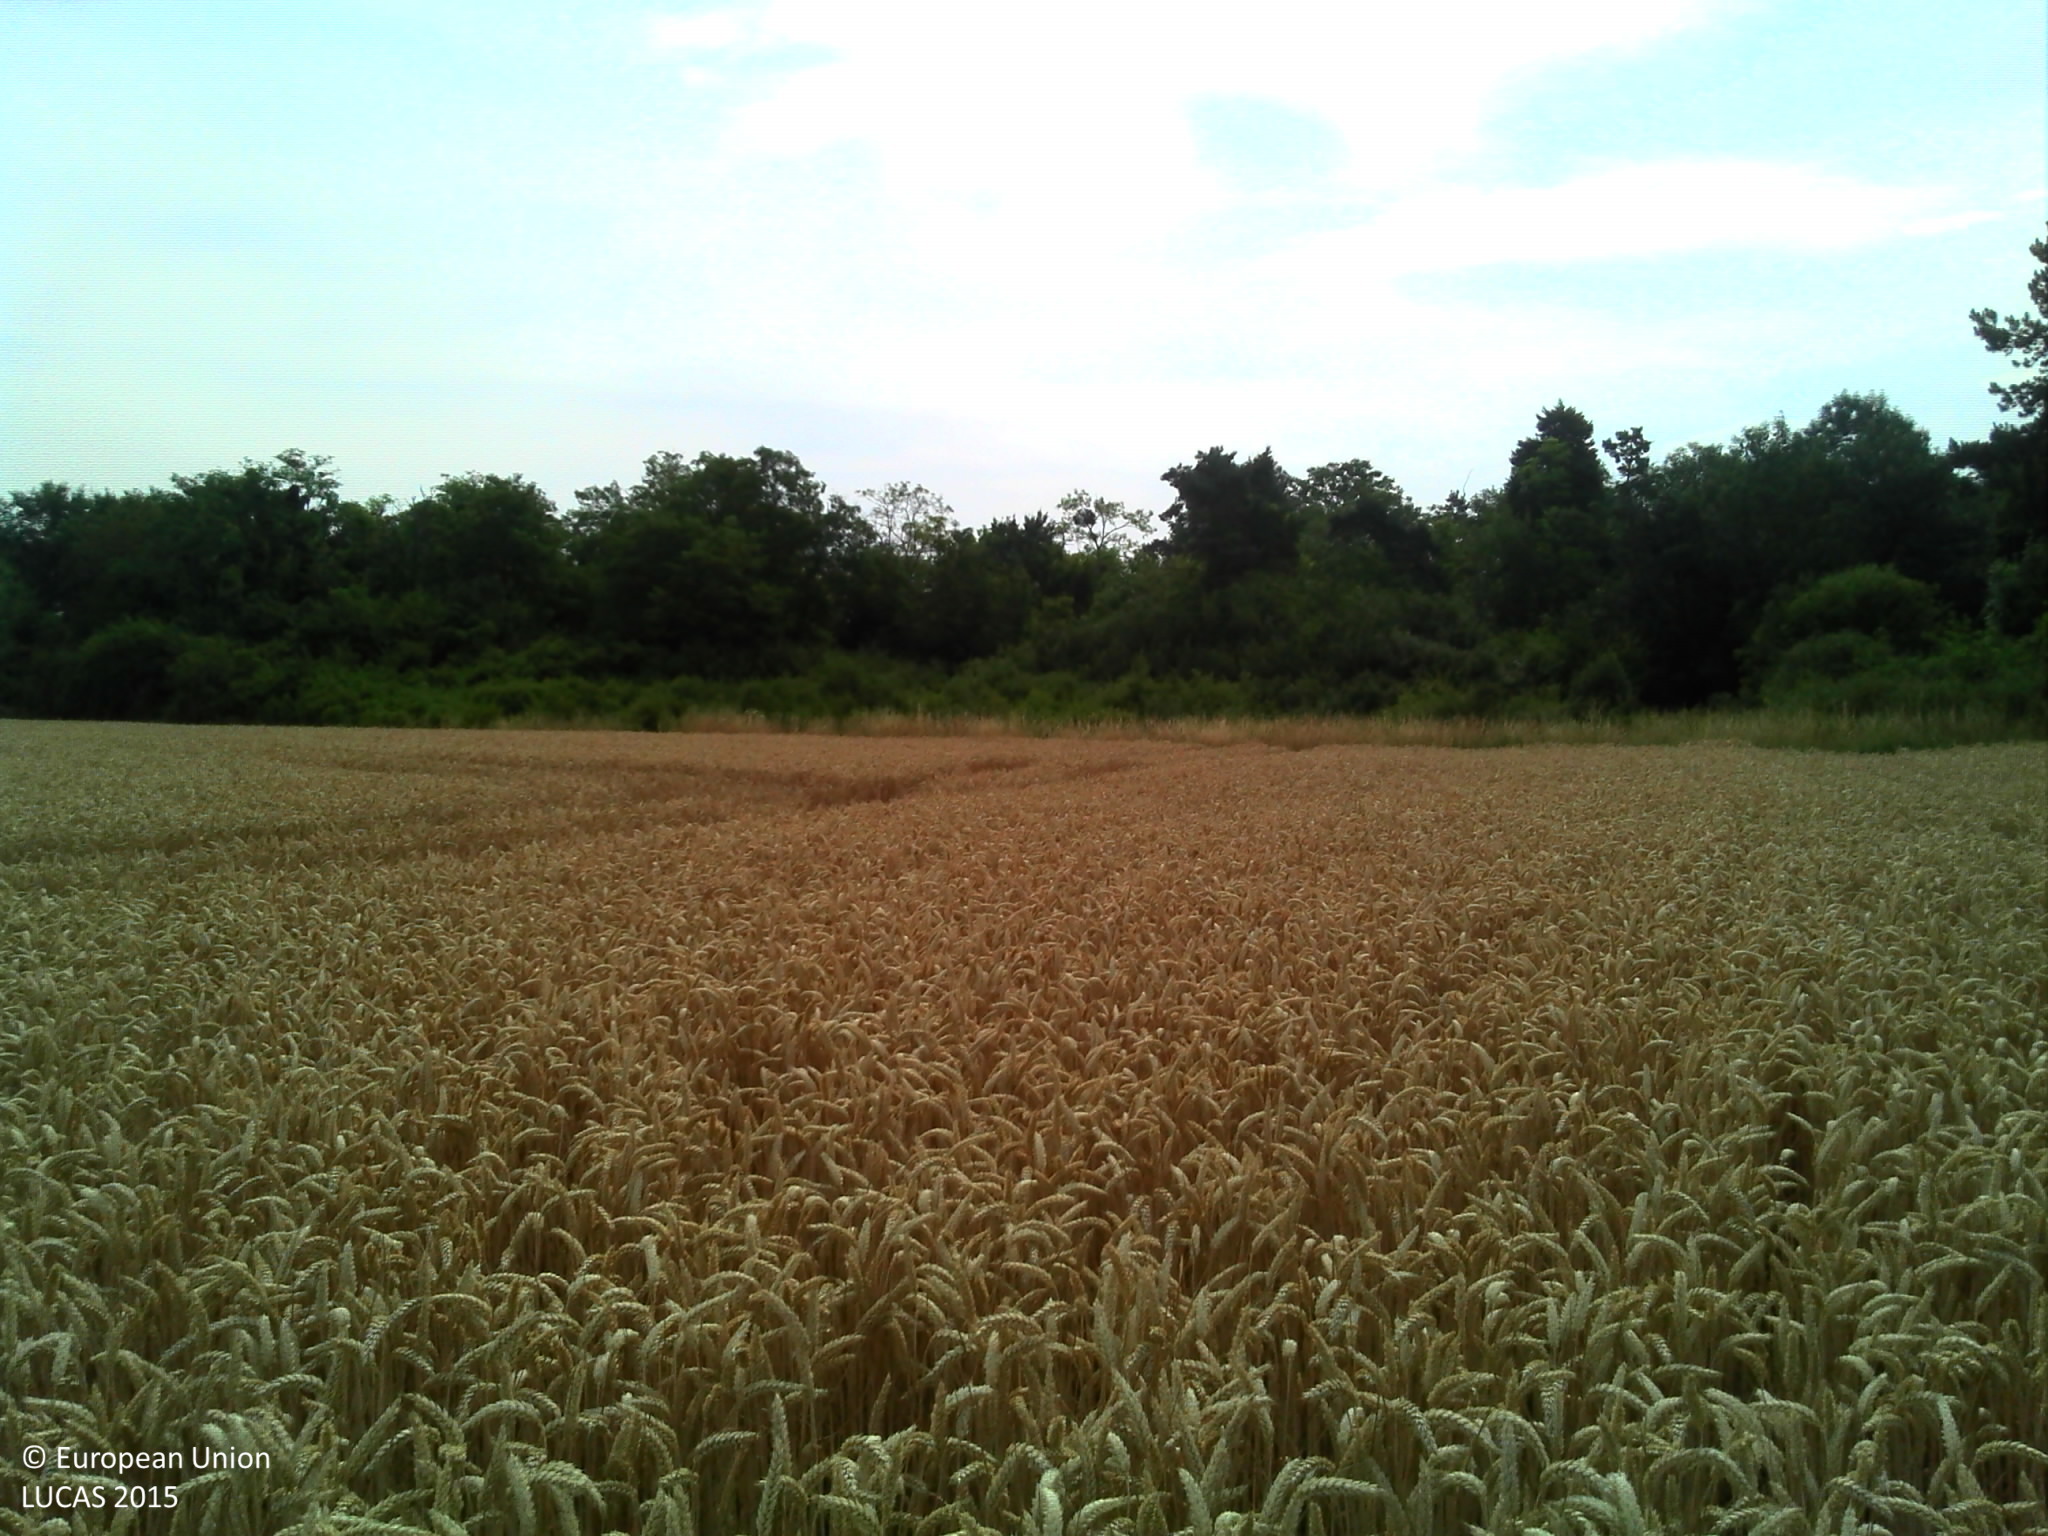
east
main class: Cropland
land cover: Common wheat
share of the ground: > 75 %
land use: Agriculture (excluding fallow land and kitchen gardens)
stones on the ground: 10 - 25 %
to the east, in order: Common wheat; Grassland without tree/shrub cover; Broadleaved woodland; Grass margins; Tracks; Rape and turnip rape
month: July
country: FR
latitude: 47.6638
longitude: 2.8154
